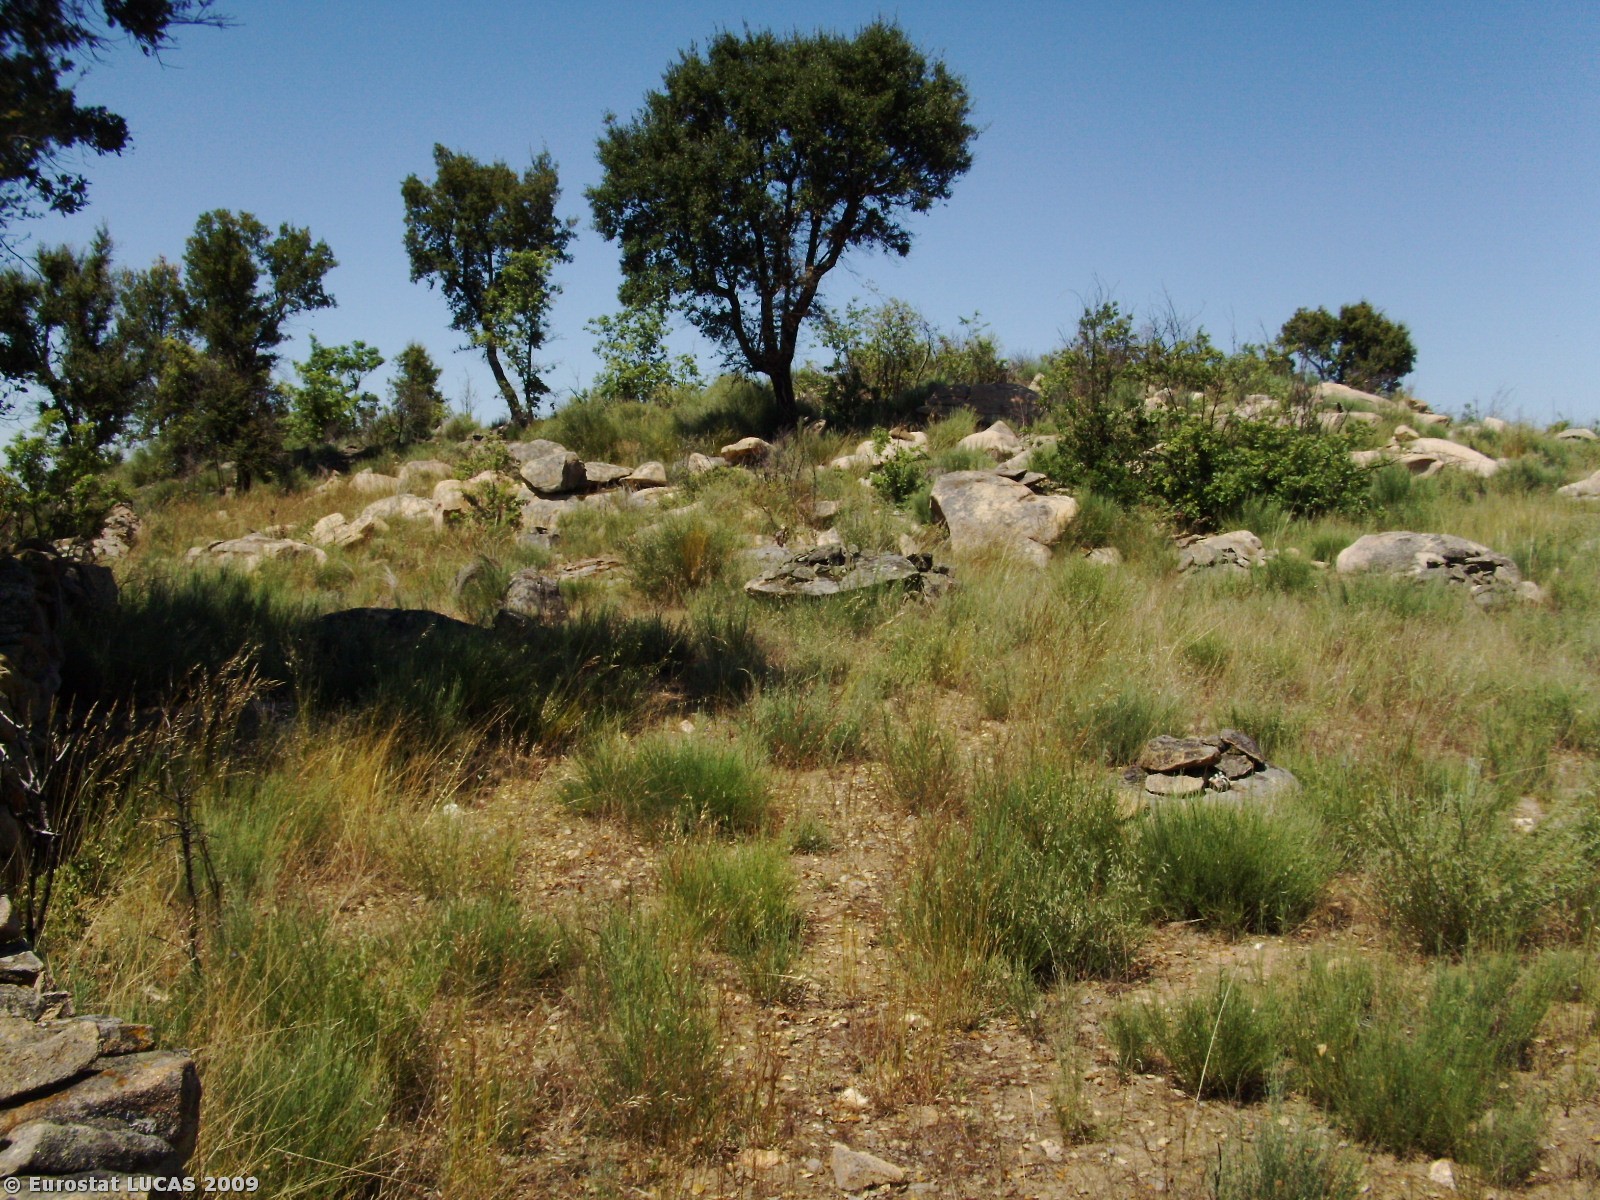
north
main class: Woodland
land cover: Broadleaved woodland
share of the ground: 25 - 50 %
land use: Forestry
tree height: > 5 m
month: May
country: PT
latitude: 40.8462
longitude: -7.1523
